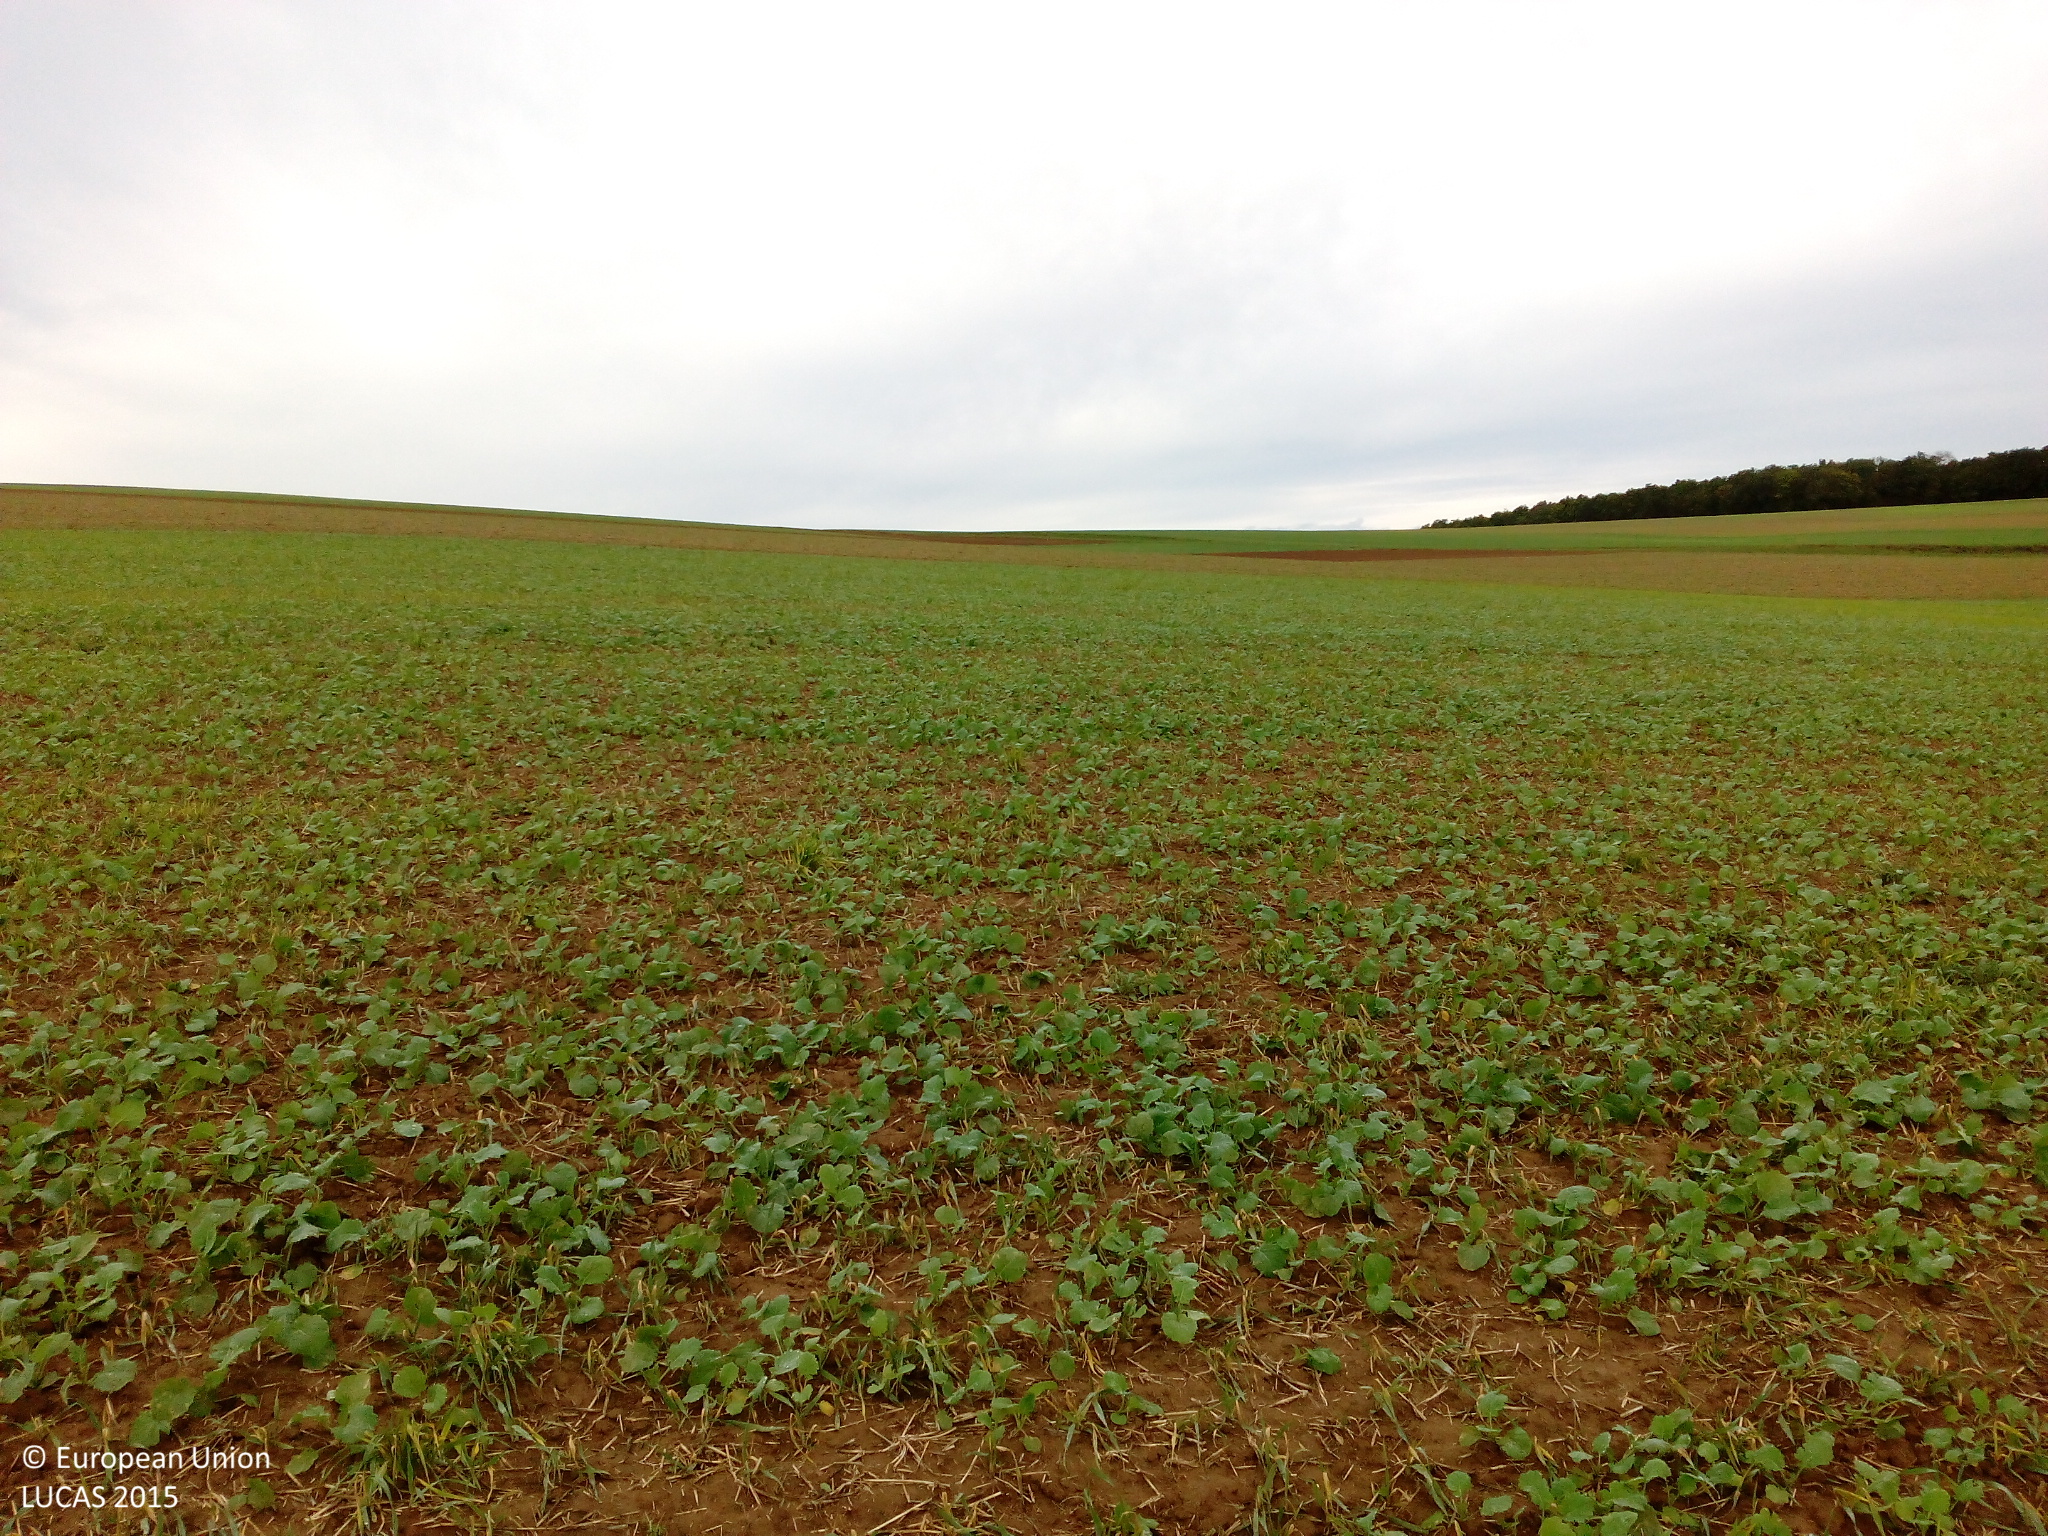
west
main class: Cropland
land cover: Barley
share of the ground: < 10 %
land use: Agriculture (excluding fallow land and kitchen gardens)
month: September
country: DE
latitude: 50.0403
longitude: 9.9023
